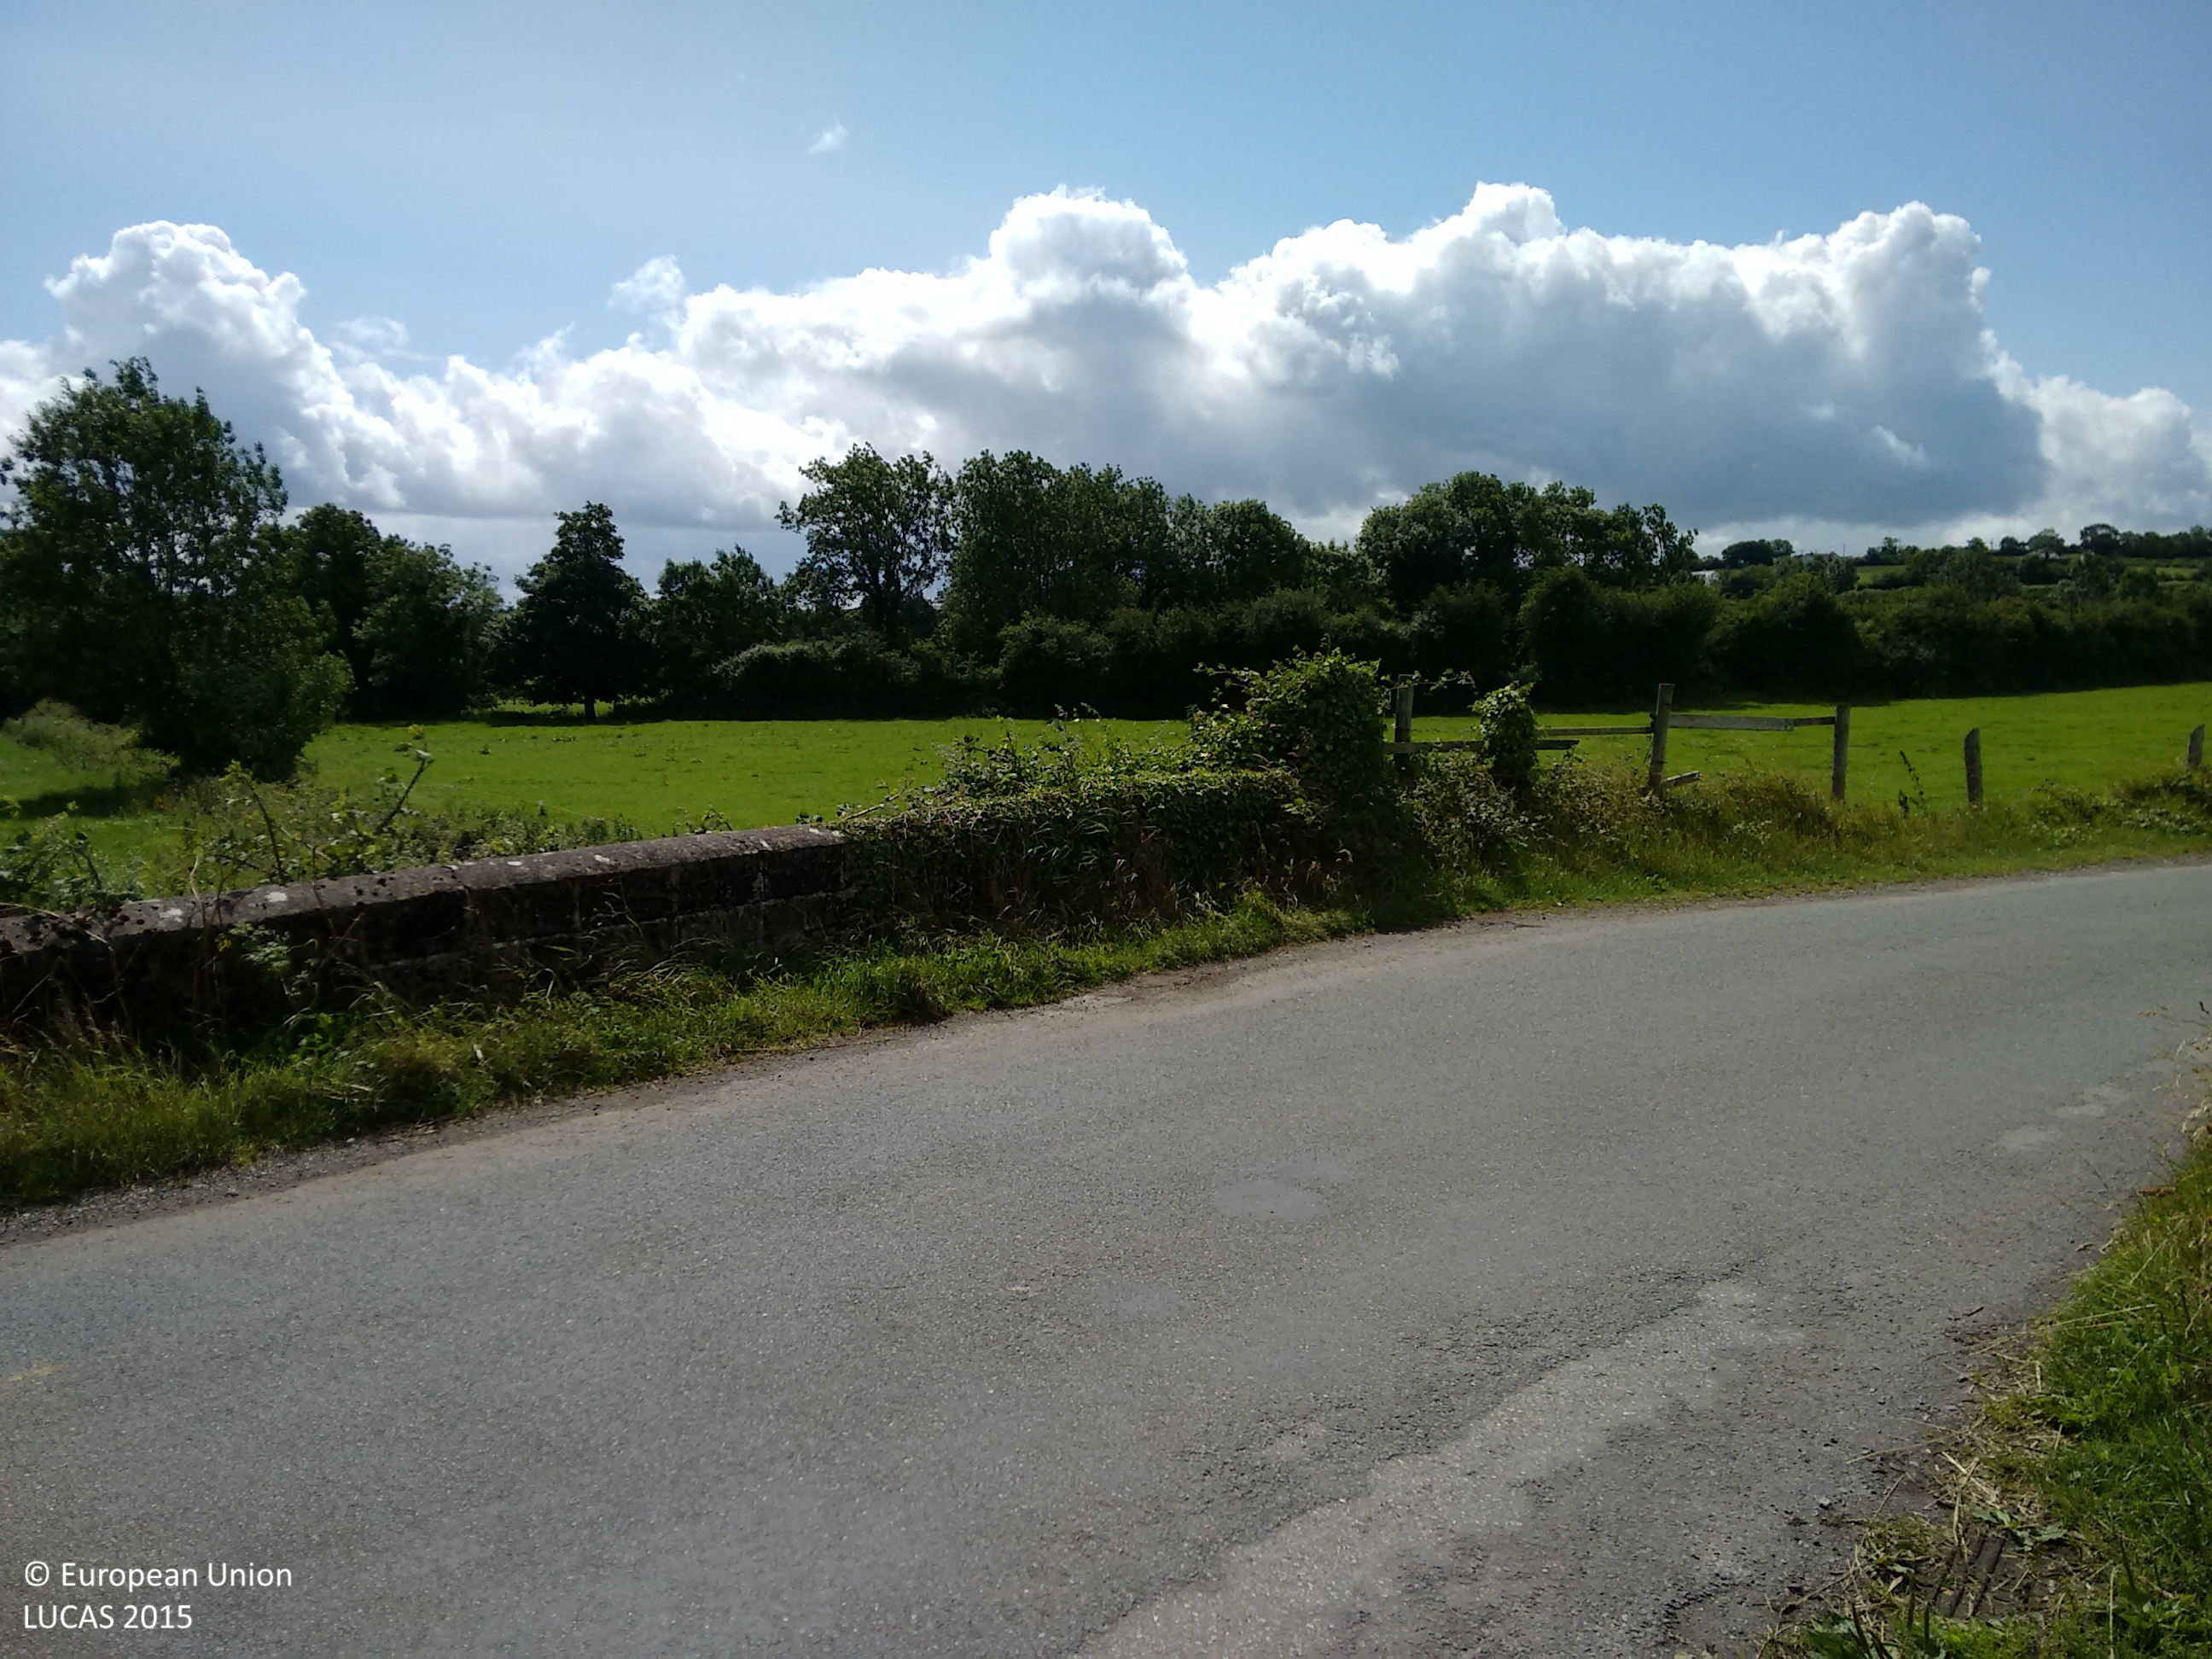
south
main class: Grassland
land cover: Grassland without tree/shrub cover
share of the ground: > 75 %
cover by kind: herbaceous plants 100 %
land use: Agriculture (excluding fallow land and kitchen gardens)
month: July
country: IE
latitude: 52.7646
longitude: -7.4522
